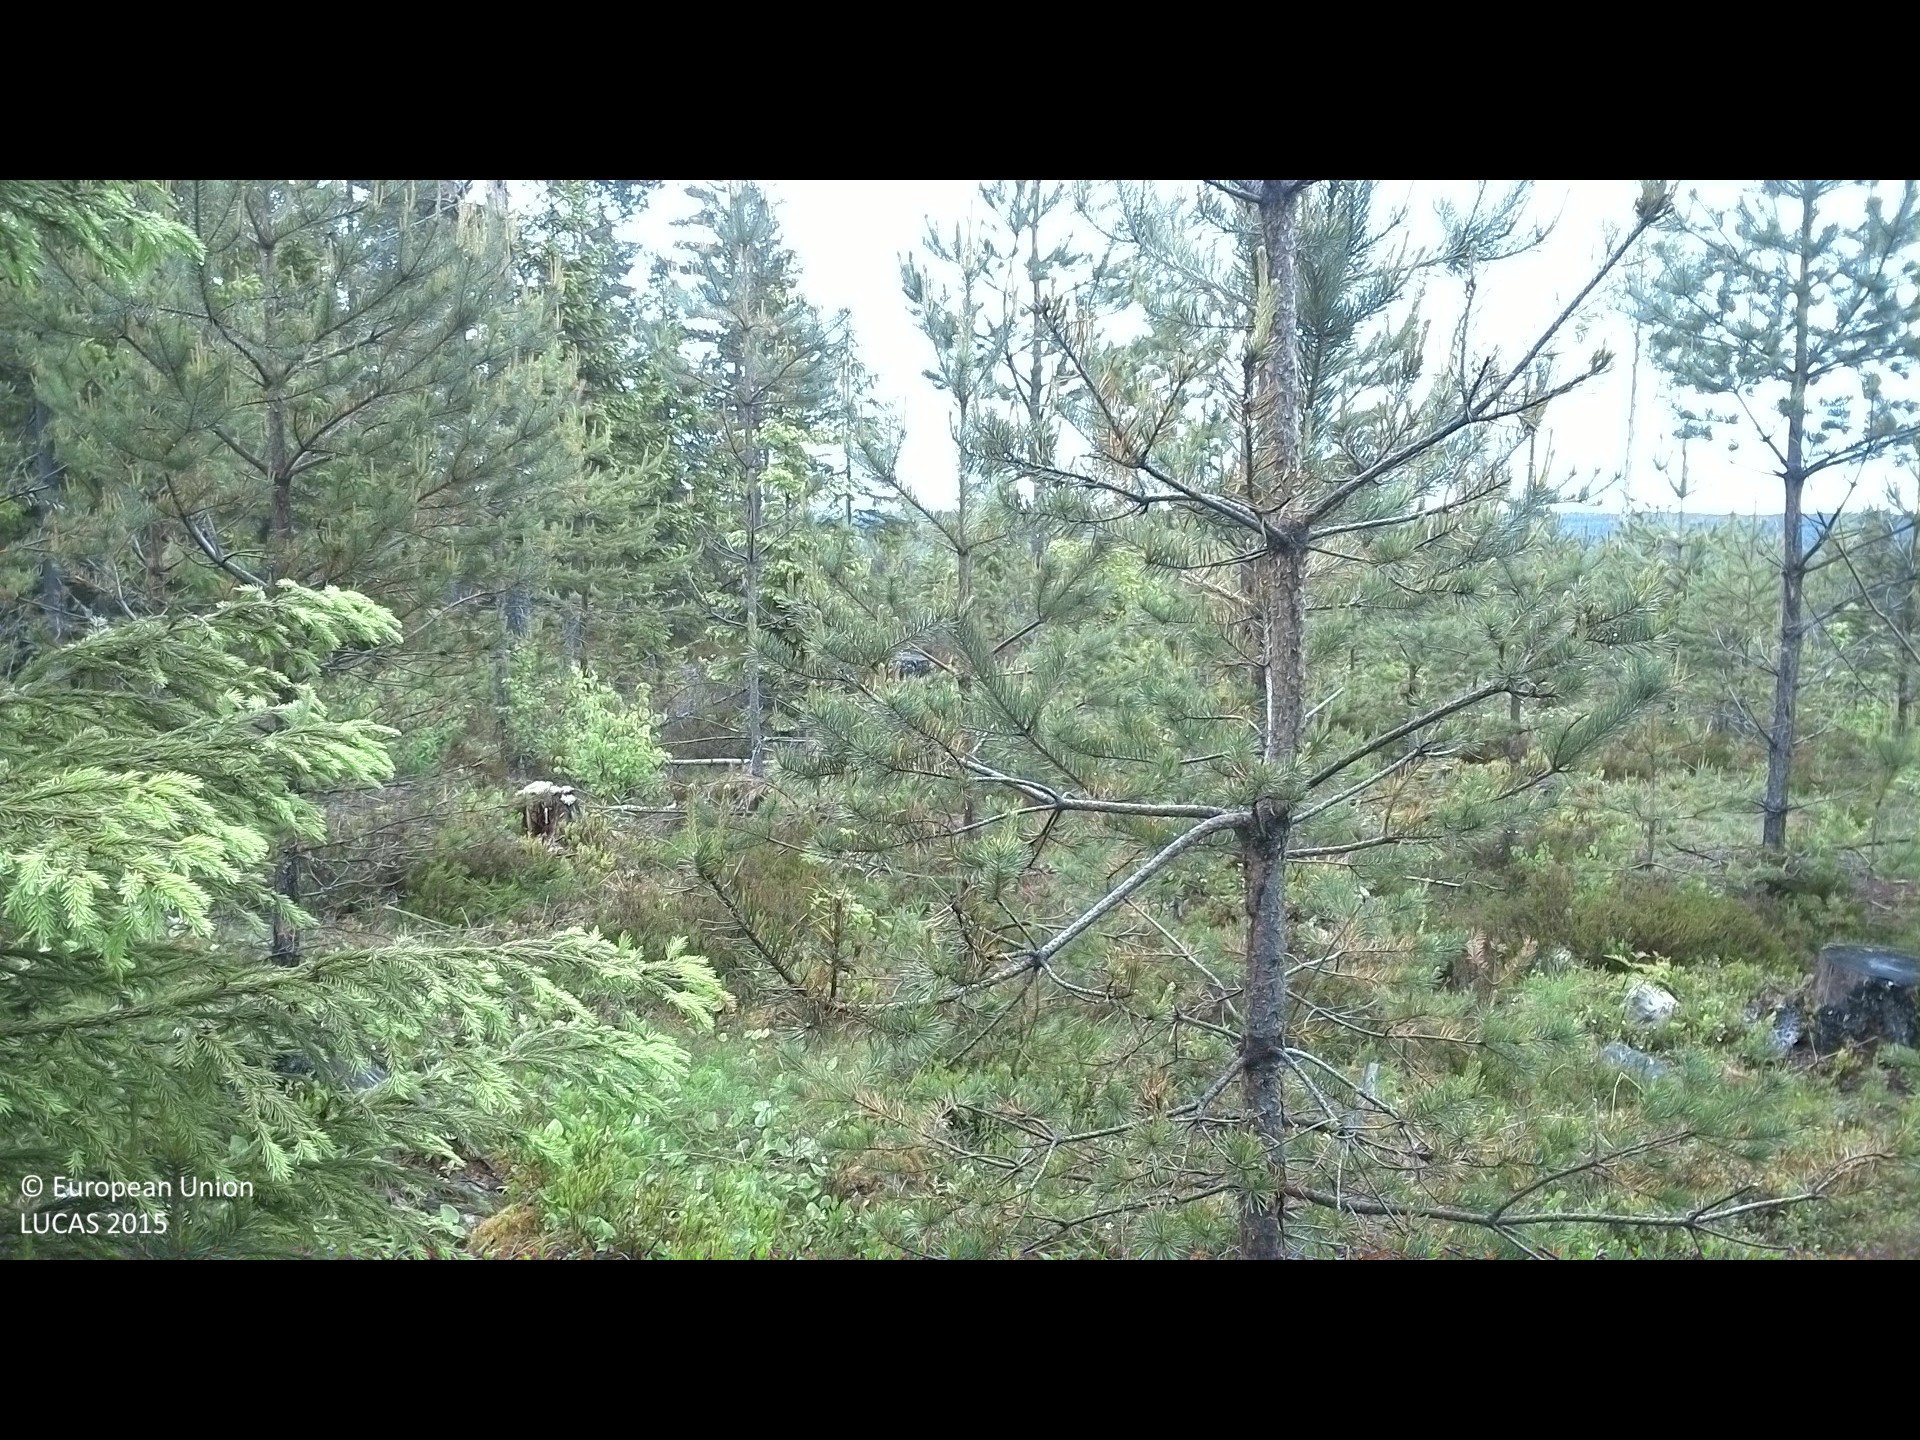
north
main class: Woodland
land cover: Pine dominated coniferous woodland
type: boreal forest
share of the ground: 25 - 50 %
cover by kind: herbaceous plants 40 %, shrubs 30 %, coniferous forest trees 25 %, broadleaved forest trees 5 %
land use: Forestry
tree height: < 5 m
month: June
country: SE
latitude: 61.8988
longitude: 17.1575
